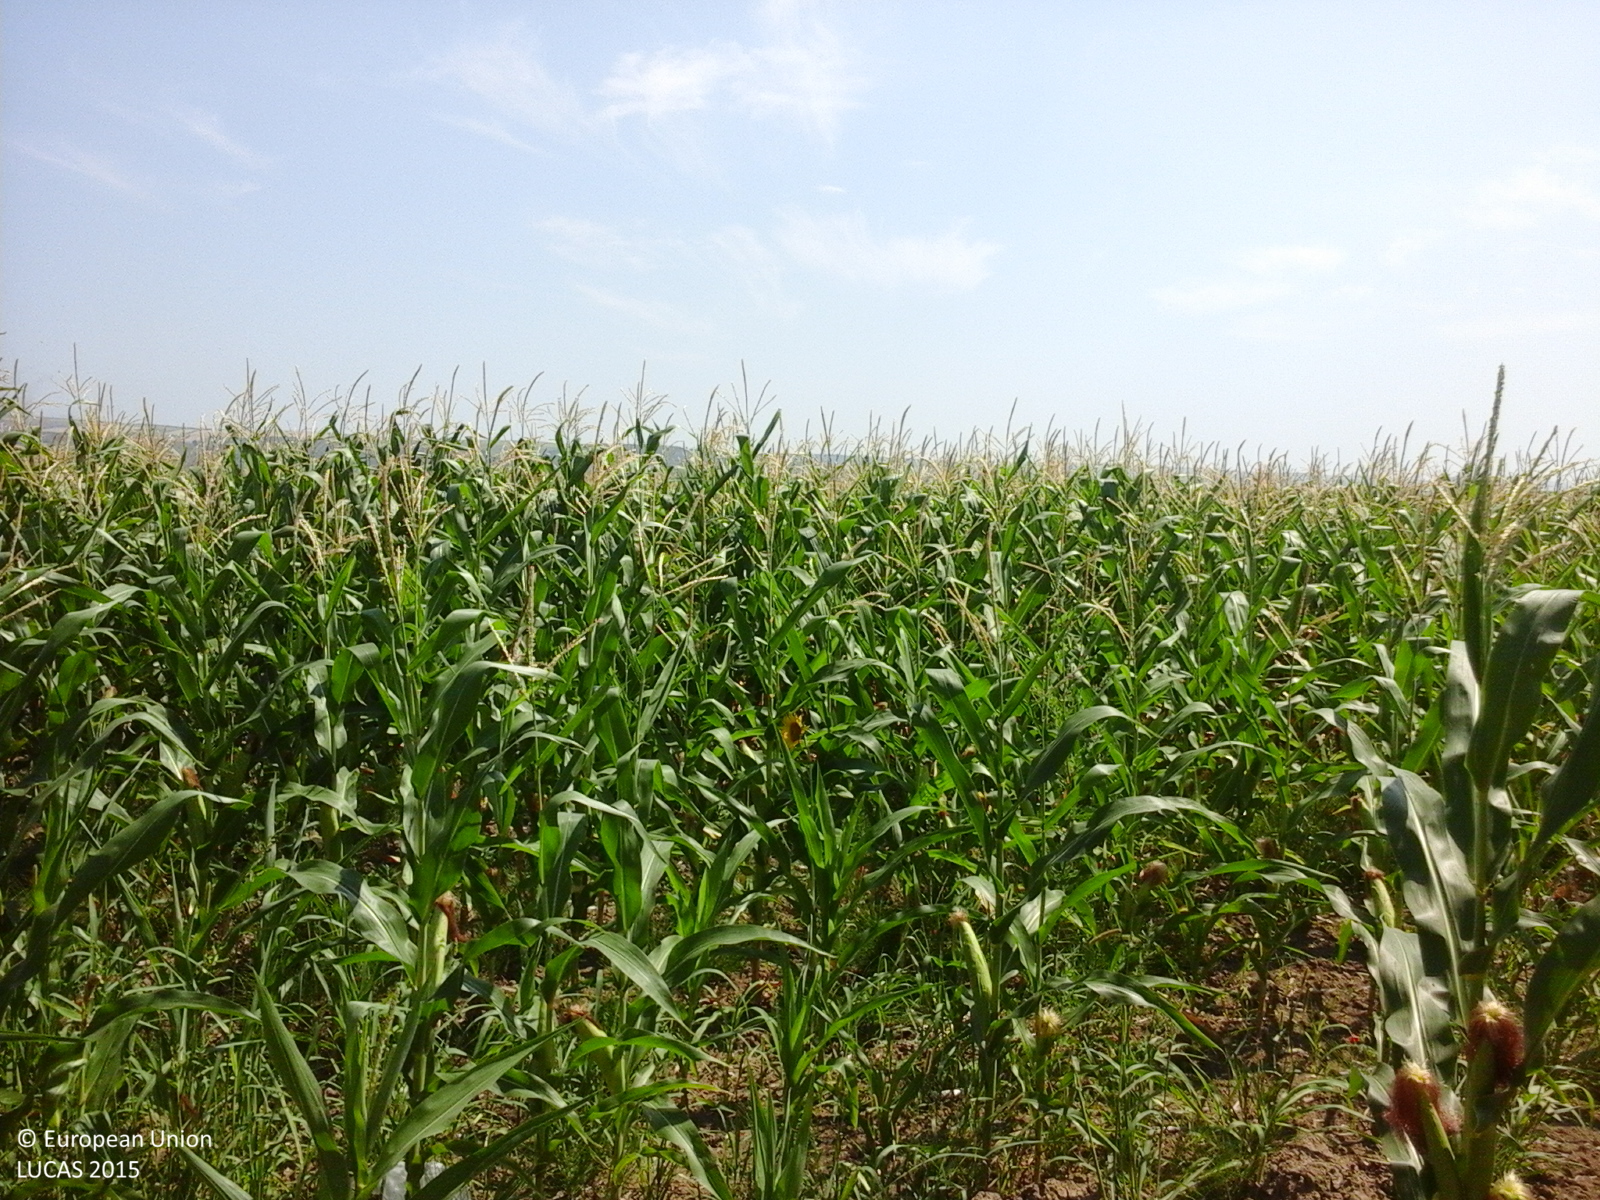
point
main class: Cropland
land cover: Maize
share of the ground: > 75 %
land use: Agriculture (excluding fallow land and kitchen gardens)
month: August
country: RO
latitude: 46.2485
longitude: 27.1014
